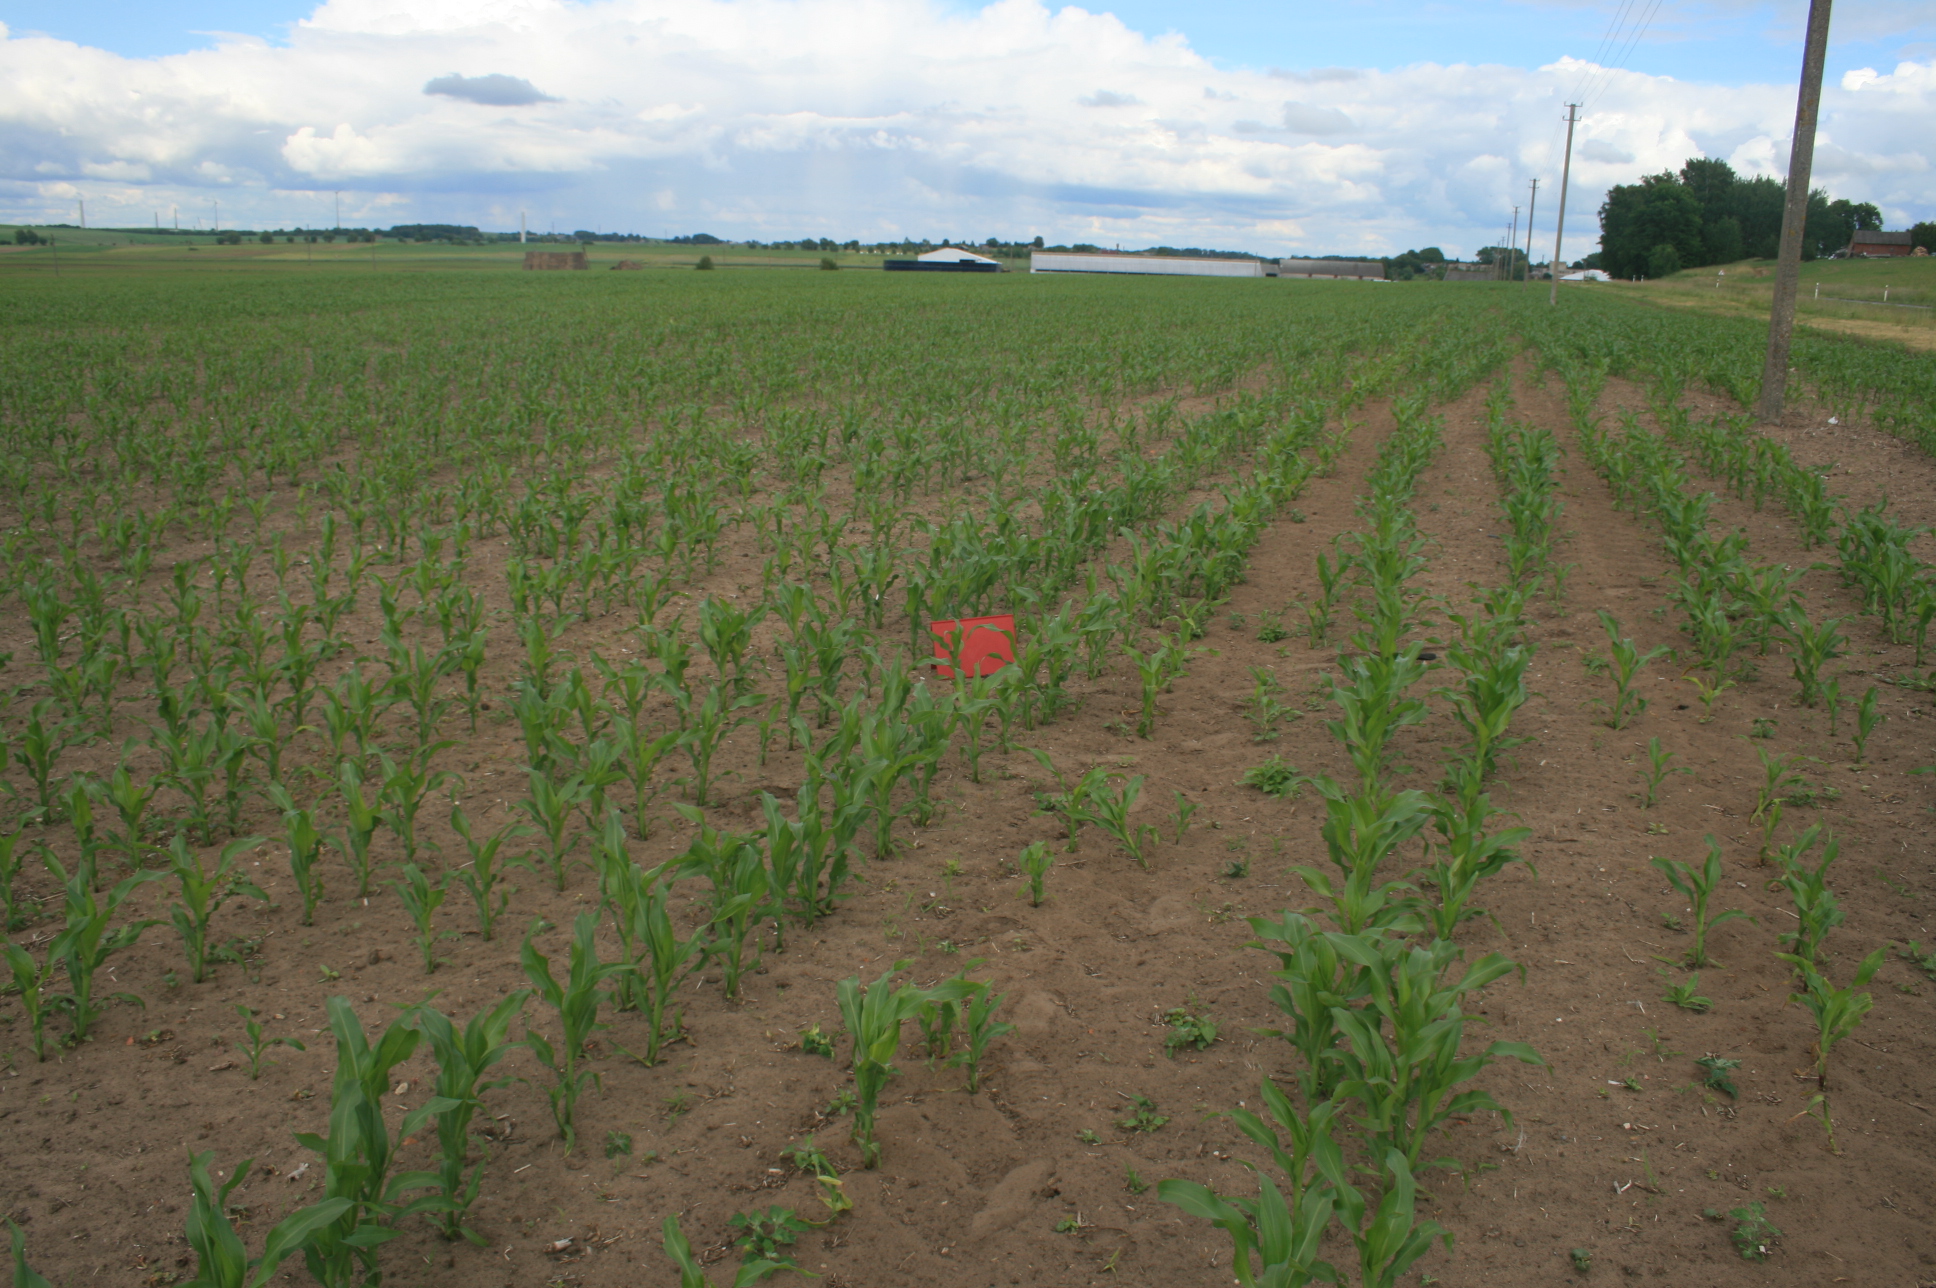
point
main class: Cropland
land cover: Maize
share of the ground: 50 - 75 %
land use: Agriculture (excluding fallow land and kitchen gardens)
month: June
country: LT
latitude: 55.1112
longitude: 22.0156
